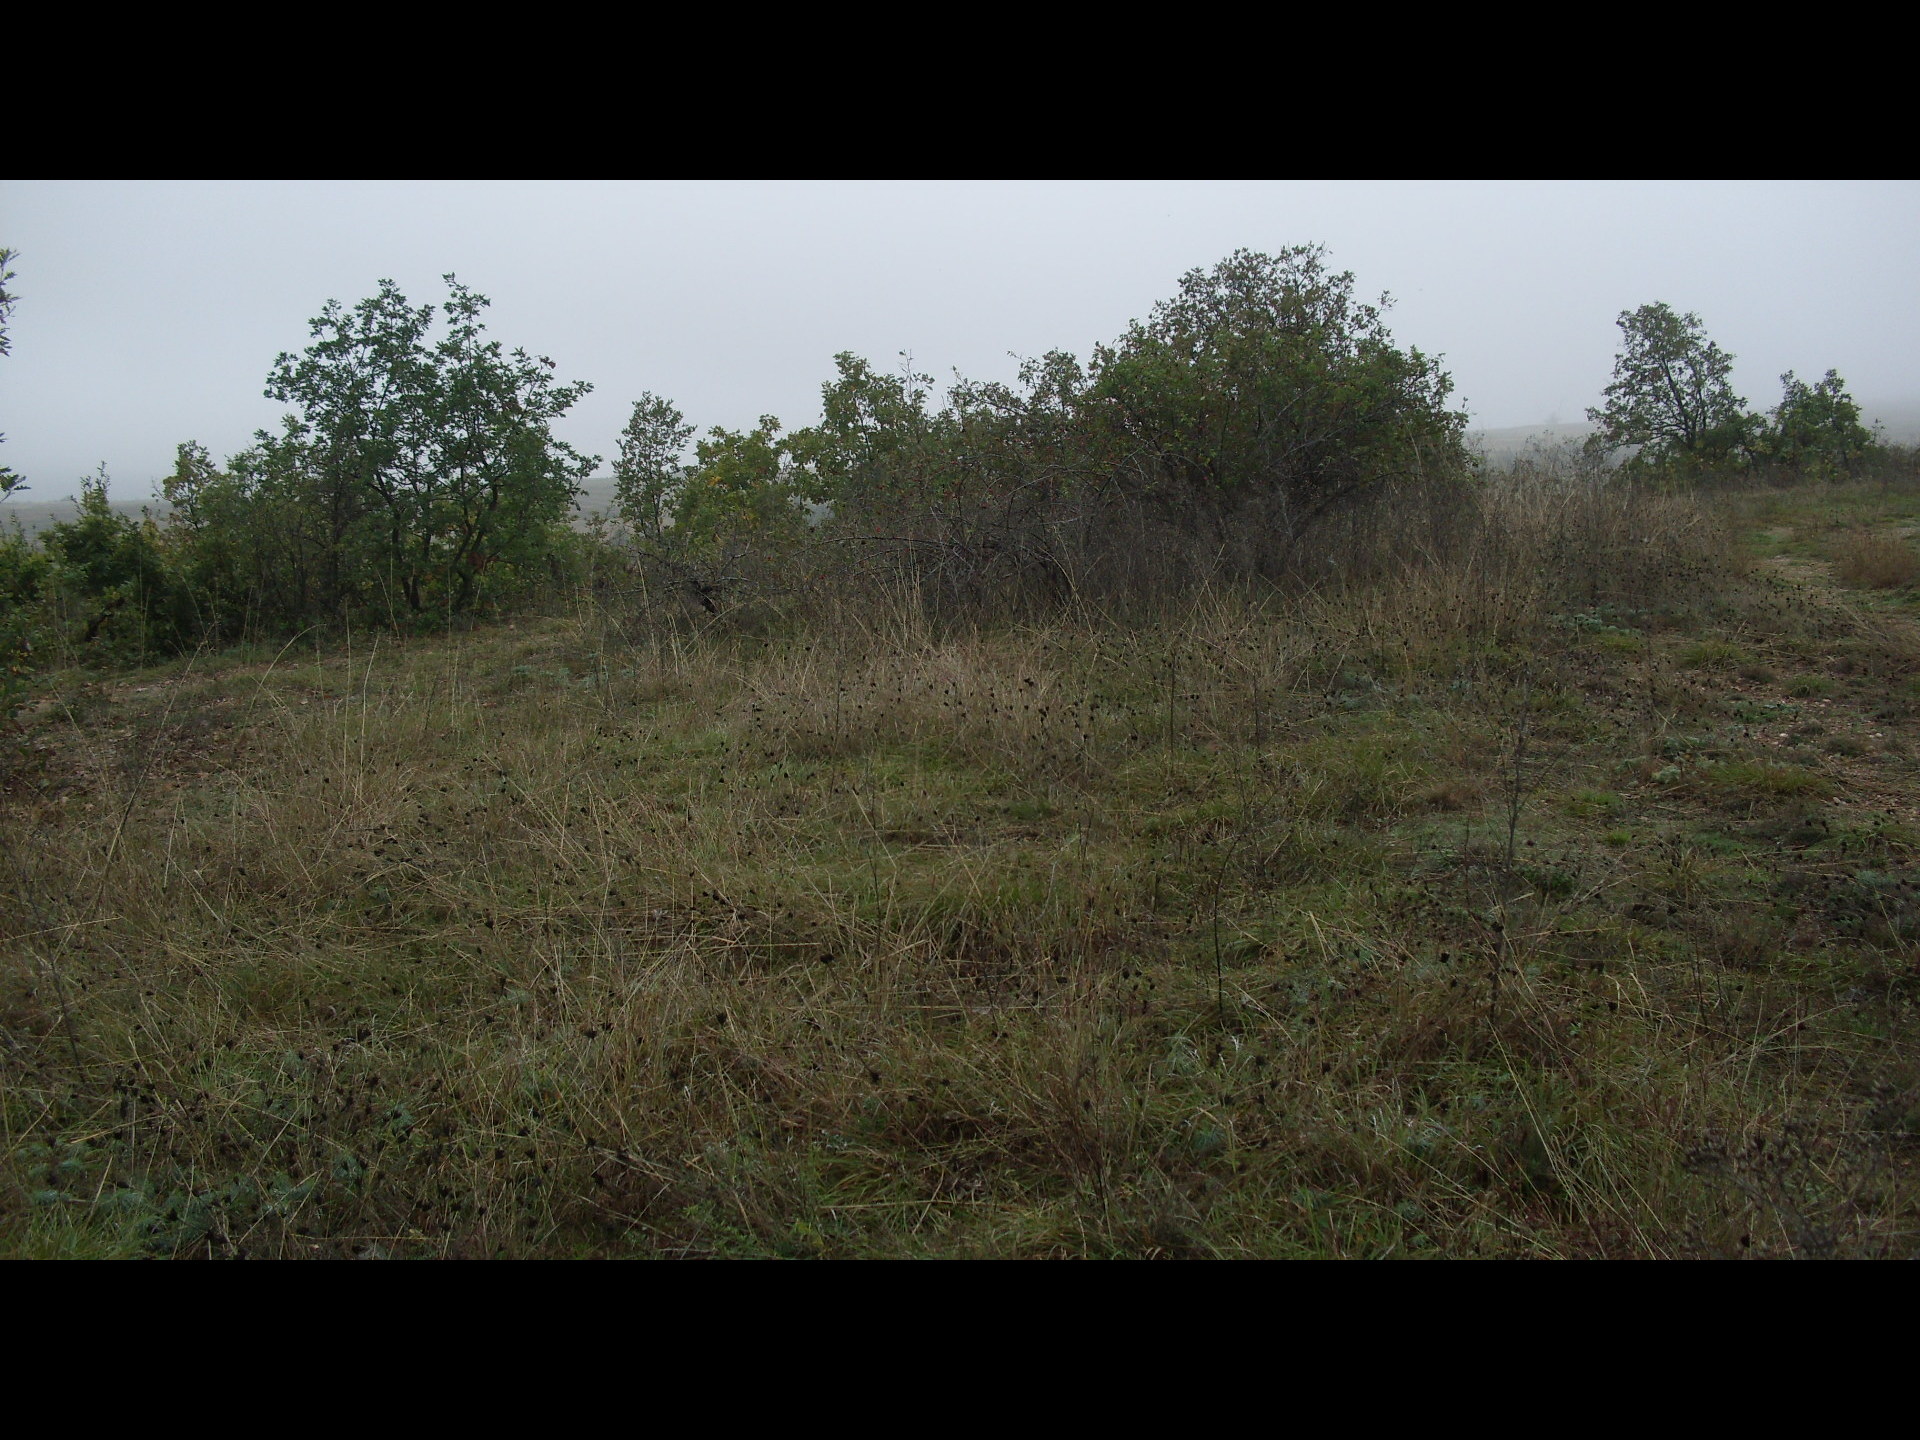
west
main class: Grassland
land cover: Grassland with sparse tree/shrub cover
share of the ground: > 75 %
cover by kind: herbaceous plants 90 %, broadleaved forest trees 5 %, shrubs 5 %
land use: Semi-natural and natural areas not in use
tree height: < 5 m
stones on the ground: < 10 %
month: October
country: BG
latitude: 43.5631
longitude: 22.8744
